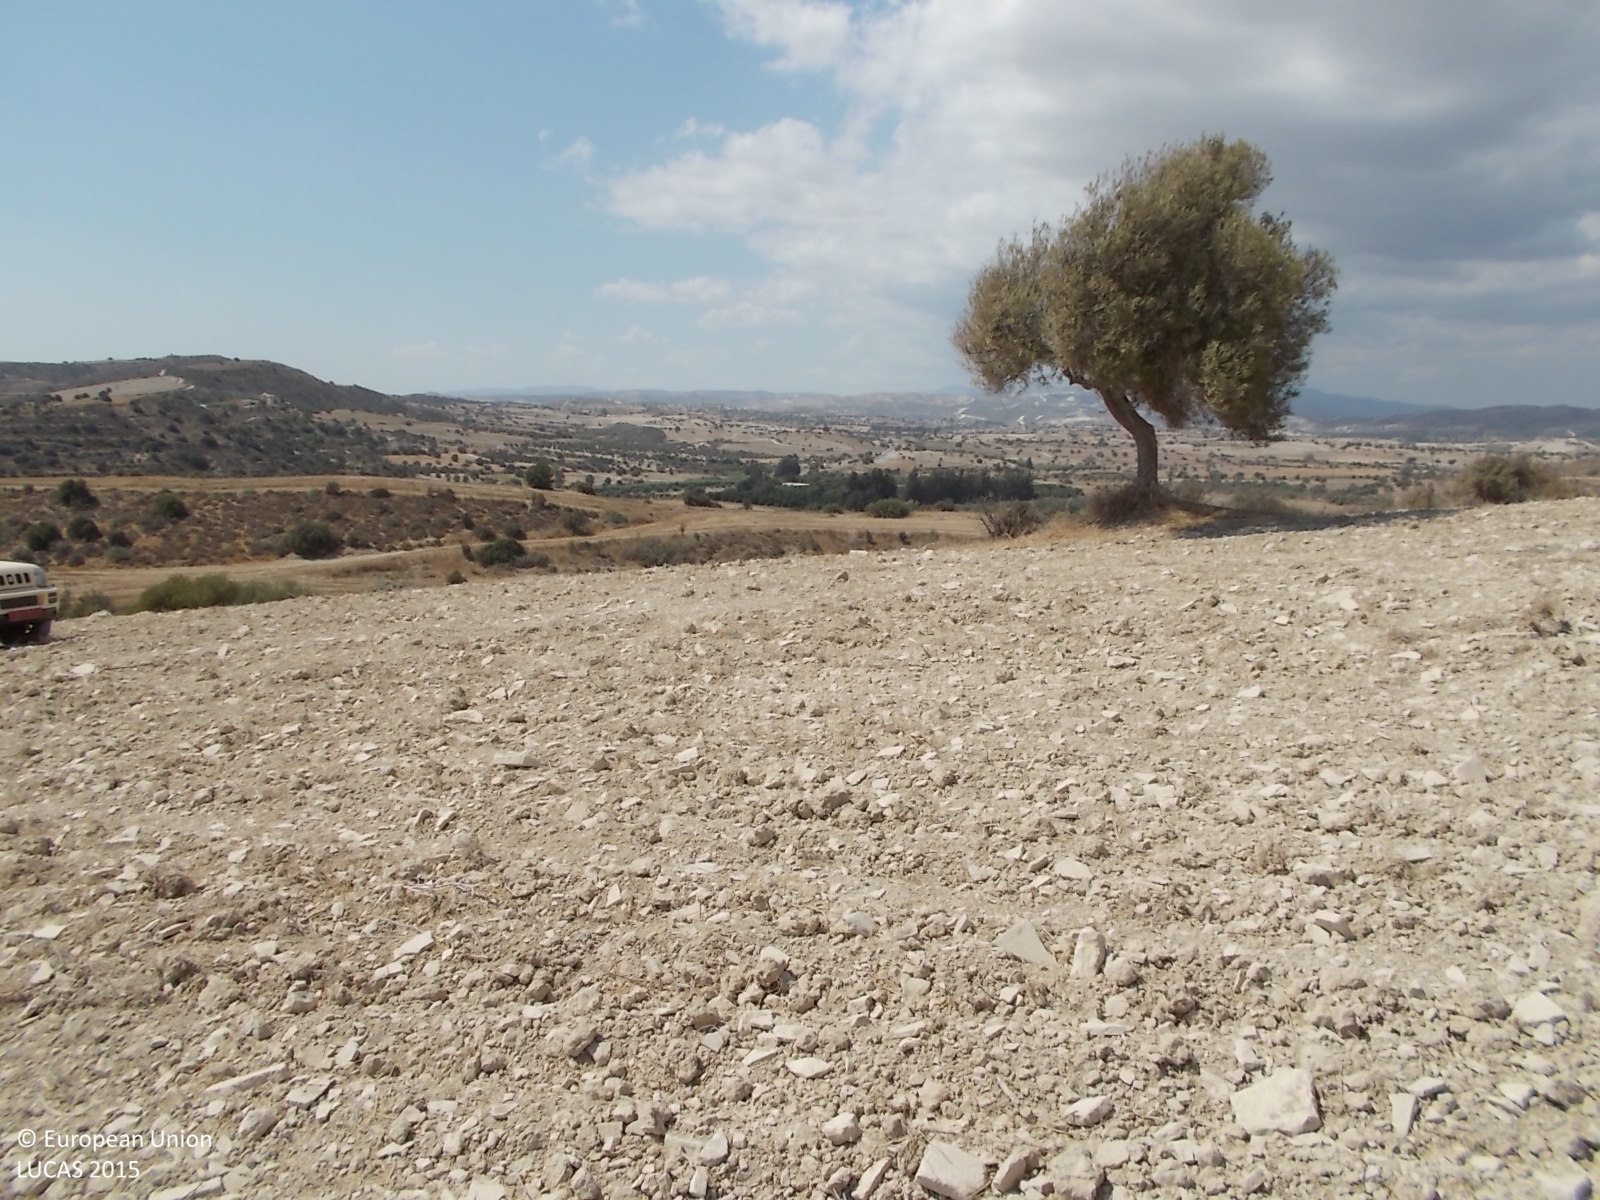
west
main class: Cropland
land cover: Olive groves
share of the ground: < 10 %
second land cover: Other bare soil
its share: > 75 %
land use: Agriculture (excluding fallow land and kitchen gardens)
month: April
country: CY
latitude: 34.8124
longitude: 33.4370
